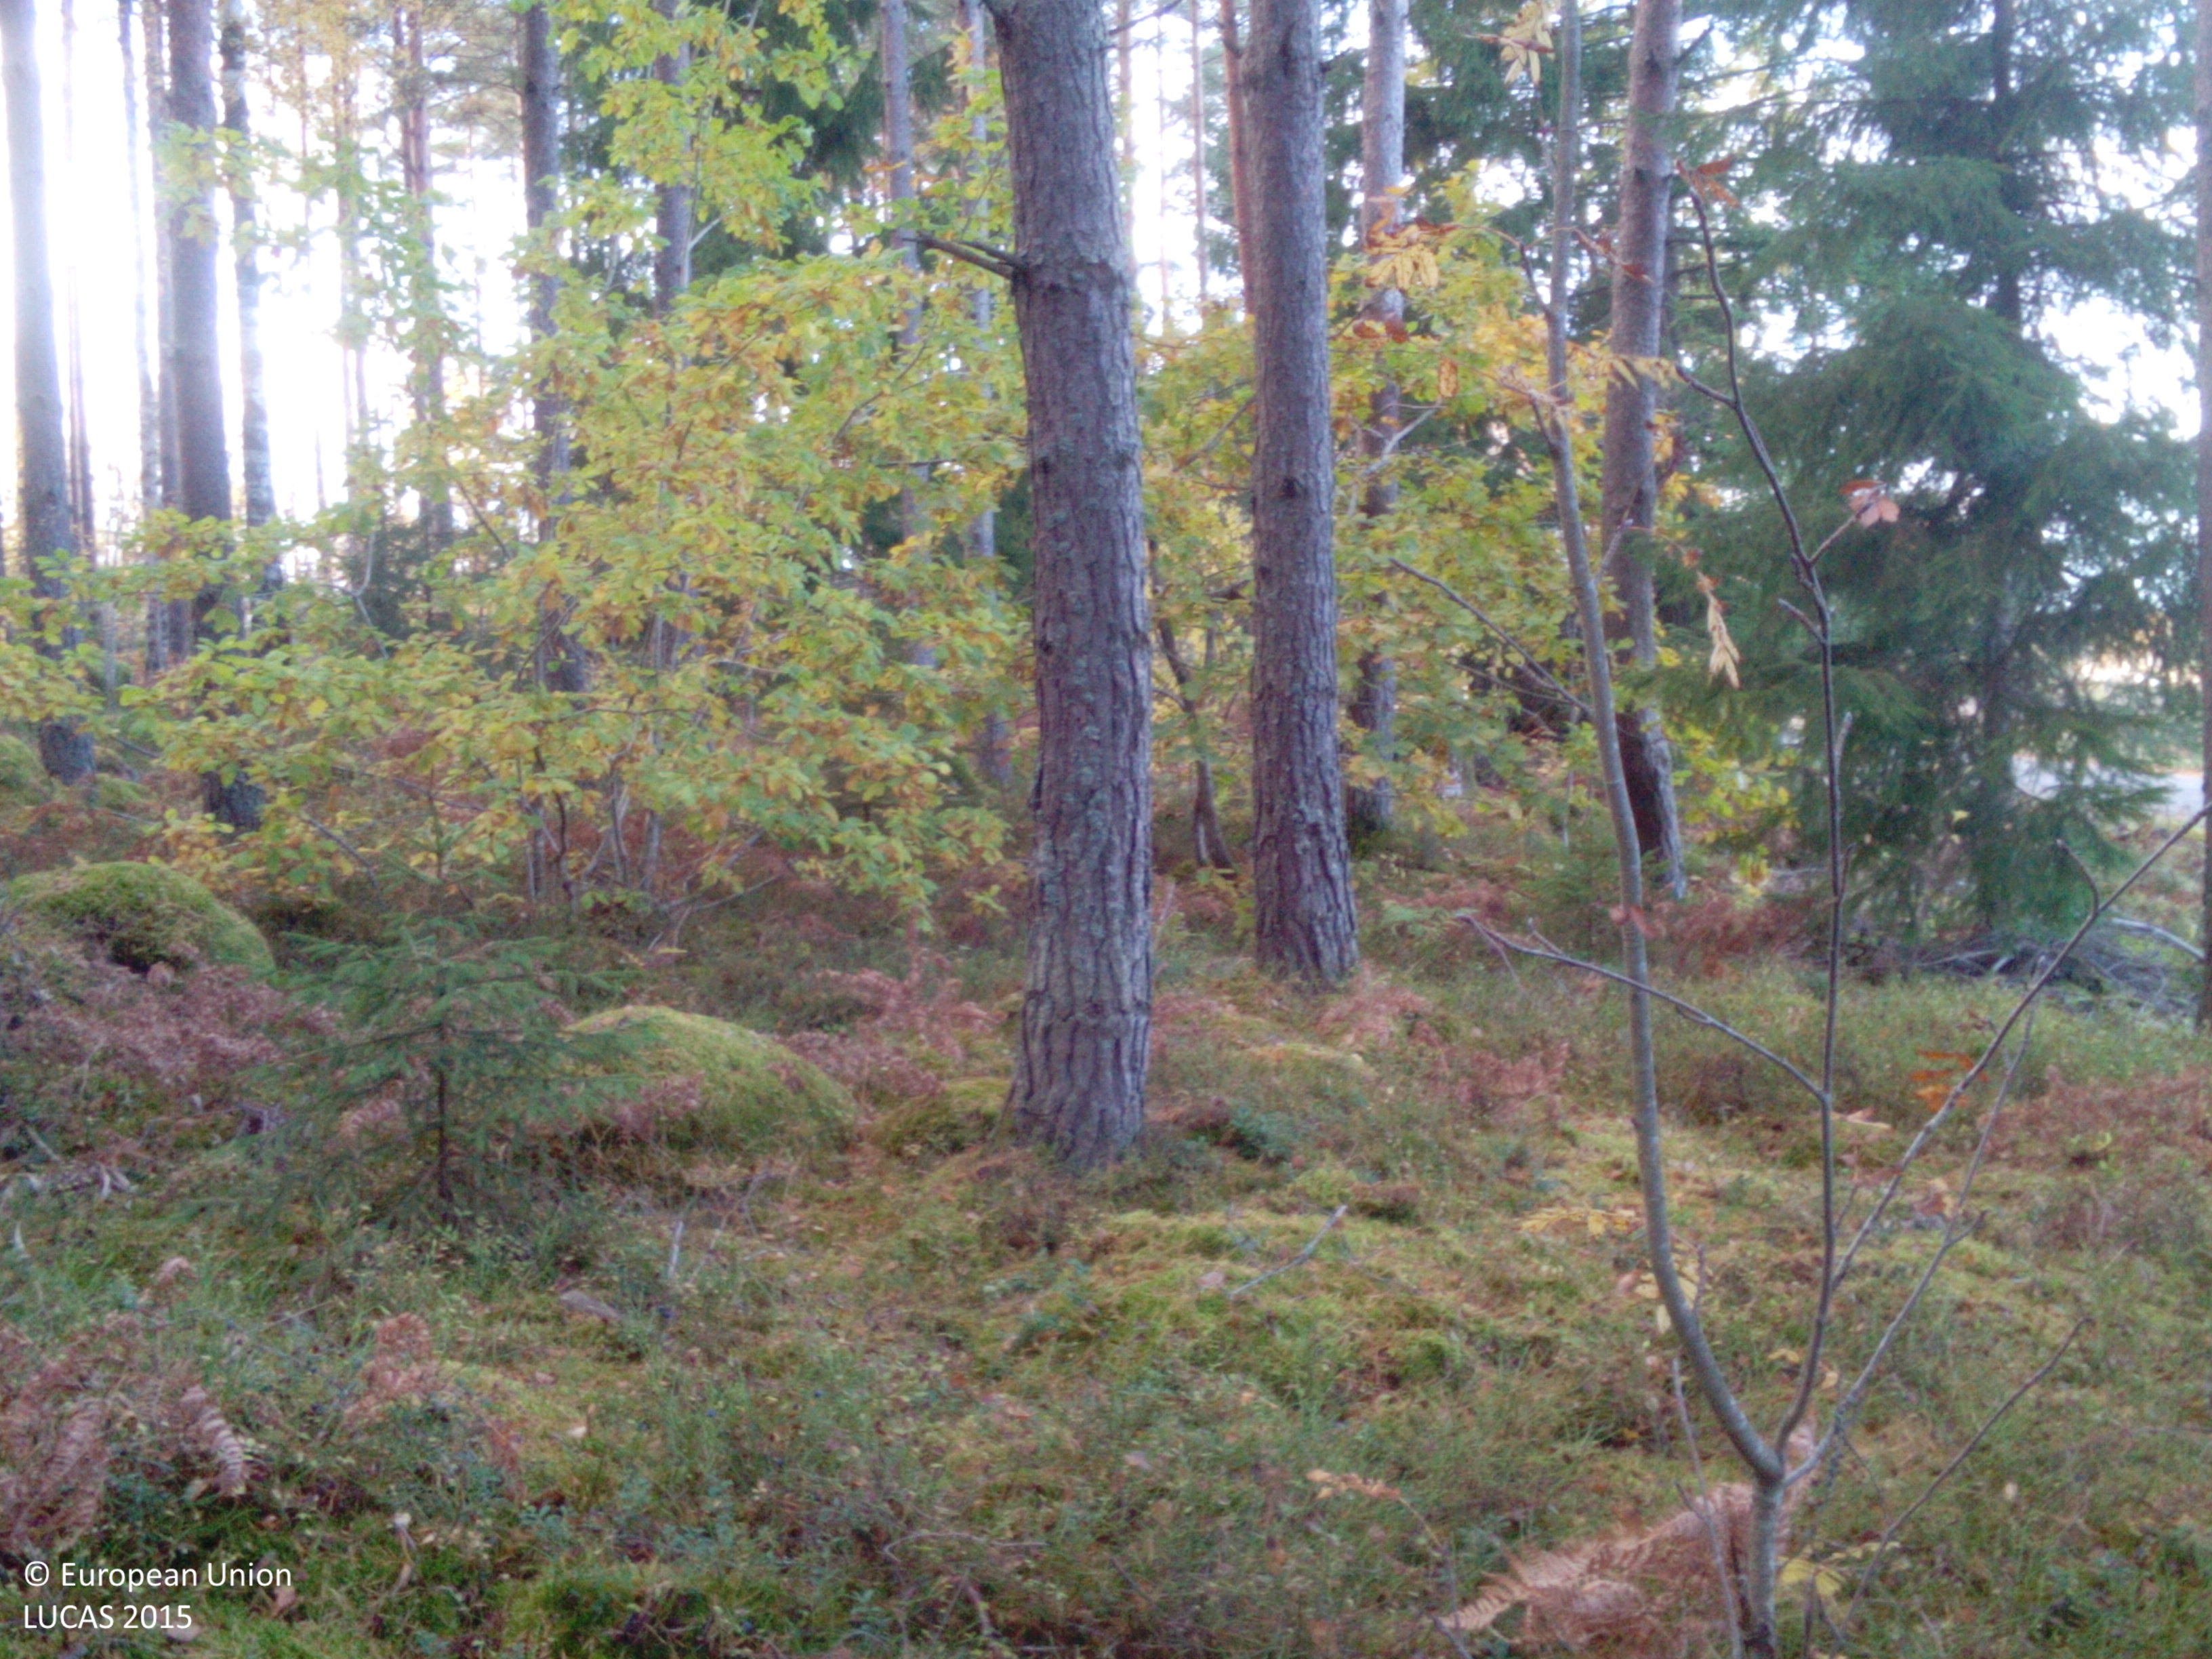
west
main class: Woodland
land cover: Other coniferous woodland
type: boreal forest
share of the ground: > 75 %
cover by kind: coniferous forest trees 85 %, lichens and mosses 10 %, herbaceous plants 5 %
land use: Forestry
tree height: > 5 m
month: October
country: SE
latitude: 59.0325
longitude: 16.2139
